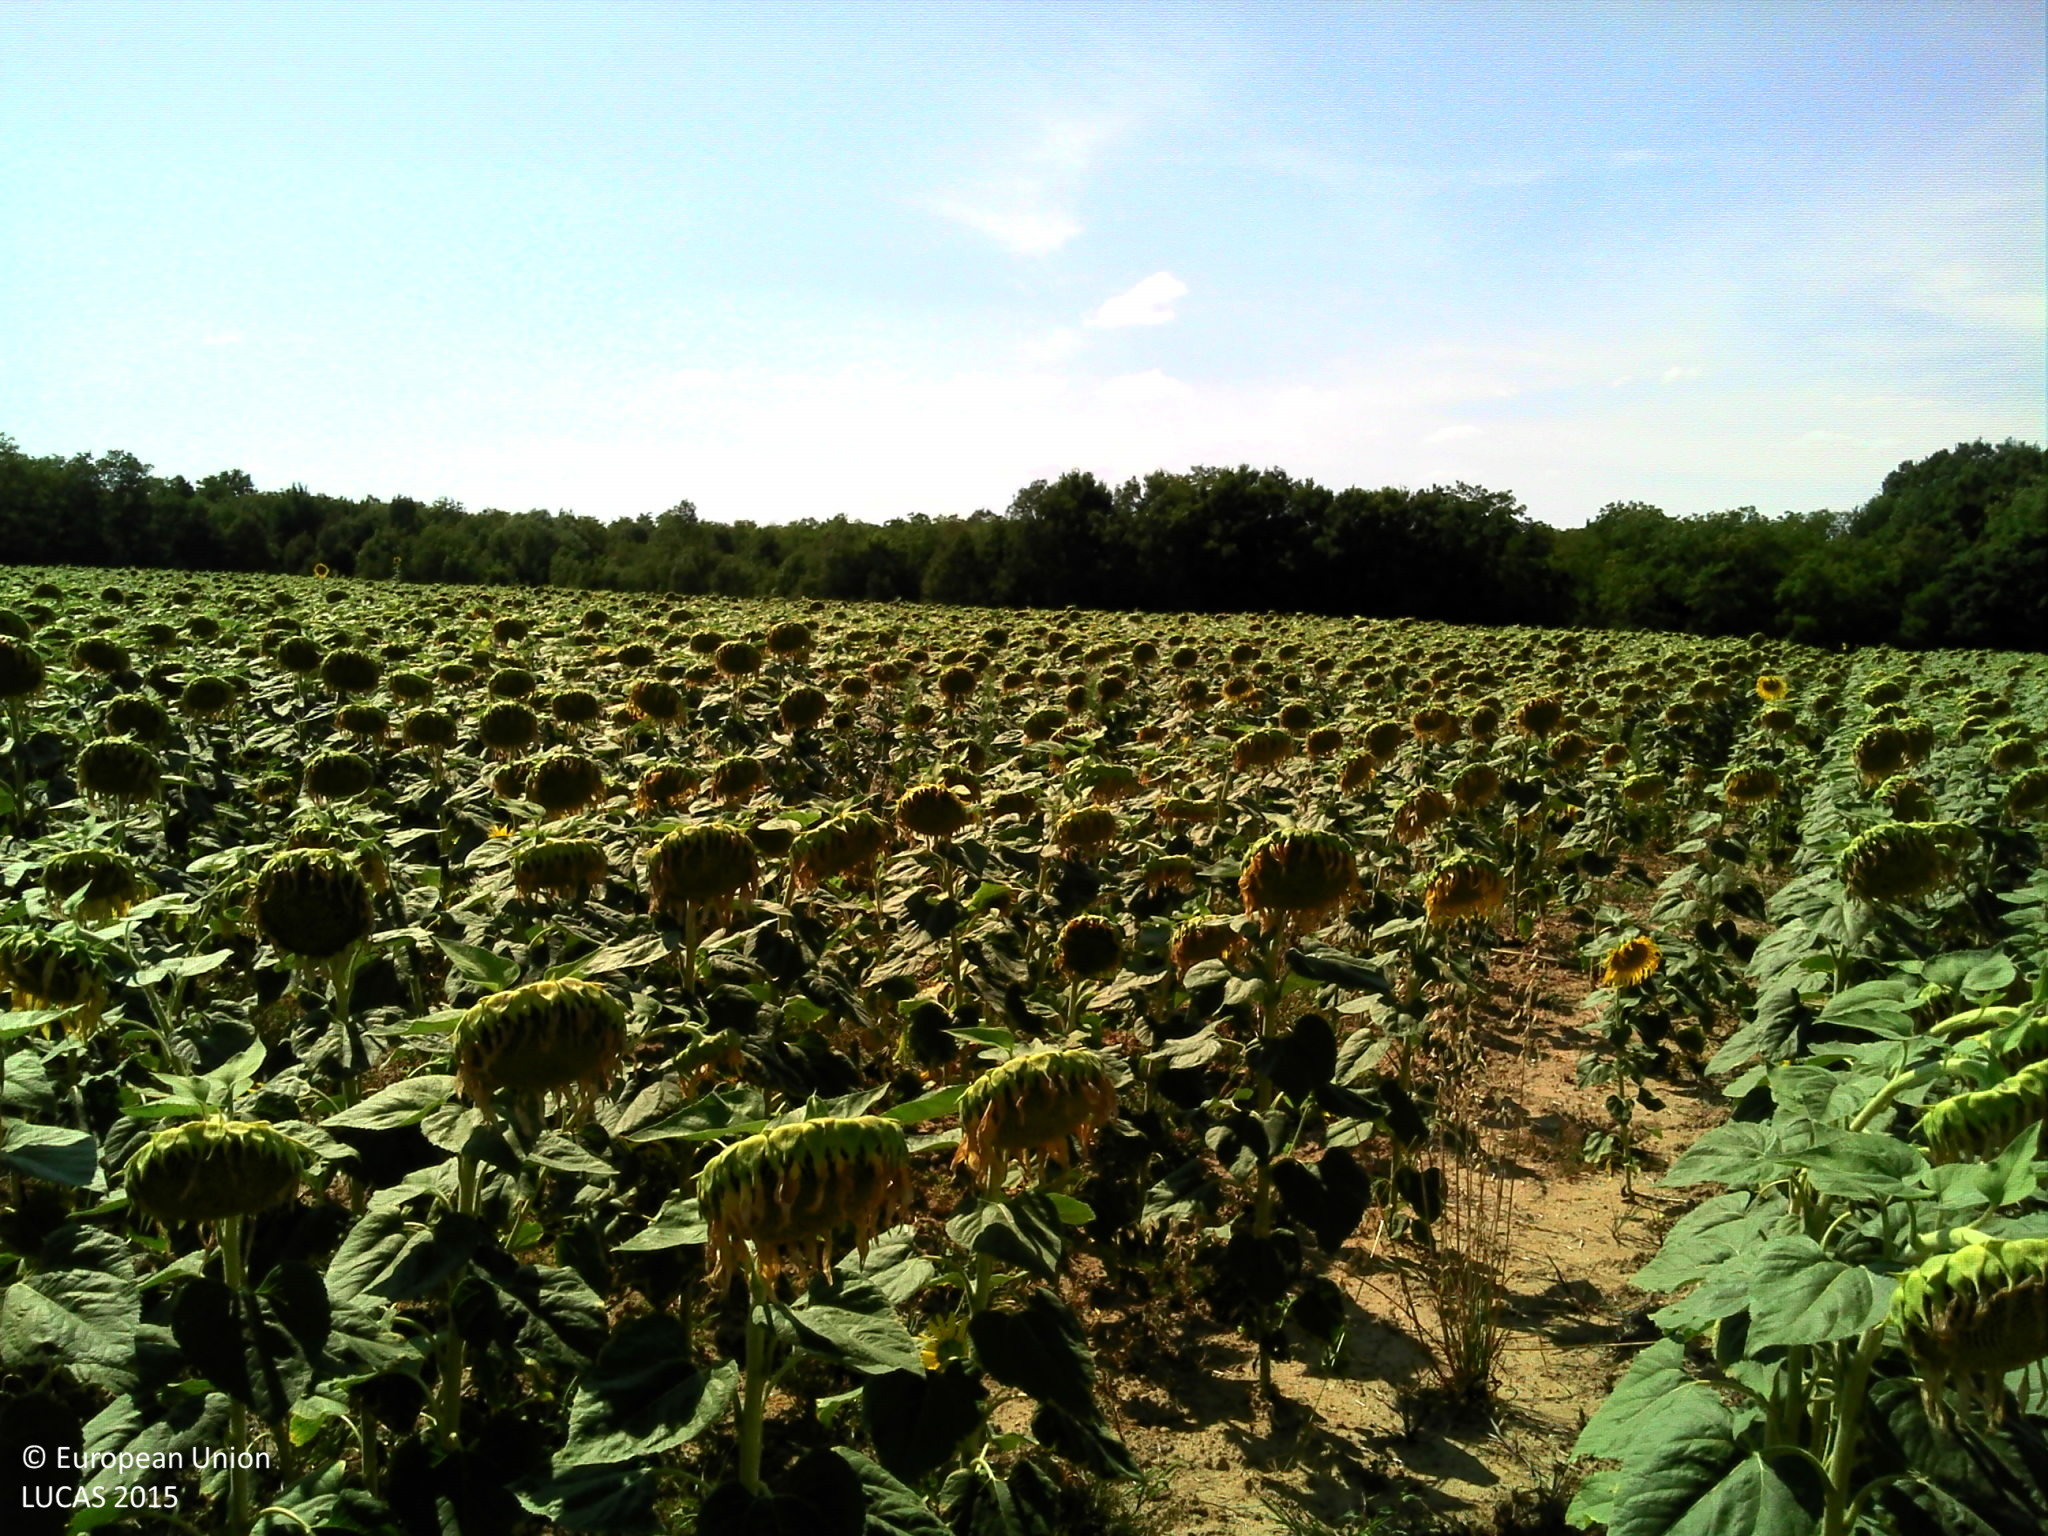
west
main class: Cropland
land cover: Sunflower
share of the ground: > 75 %
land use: Agriculture (excluding fallow land and kitchen gardens)
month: August
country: FR
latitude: 47.8830
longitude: 3.4291
